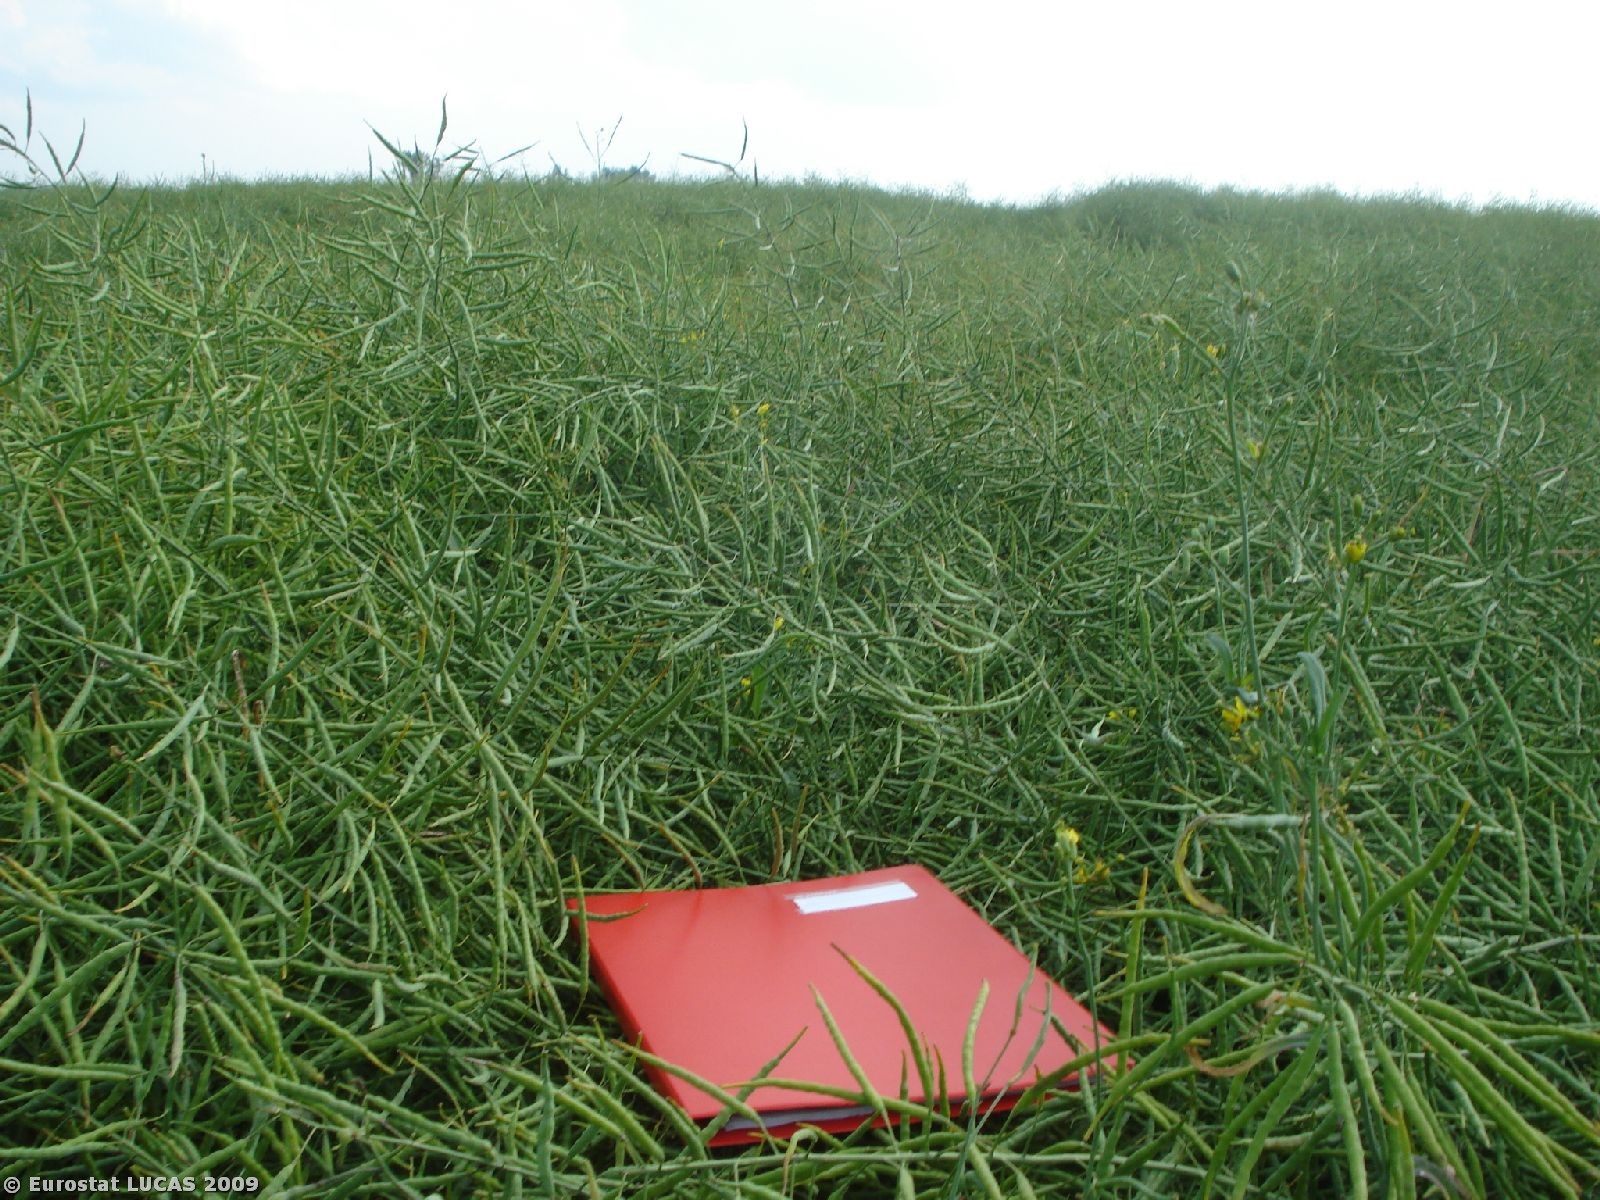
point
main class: Cropland
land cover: Rape and turnip rape
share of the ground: > 75 %
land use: Agriculture (excluding fallow land and kitchen gardens)
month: July
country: PL
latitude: 52.6579
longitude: 23.1917
